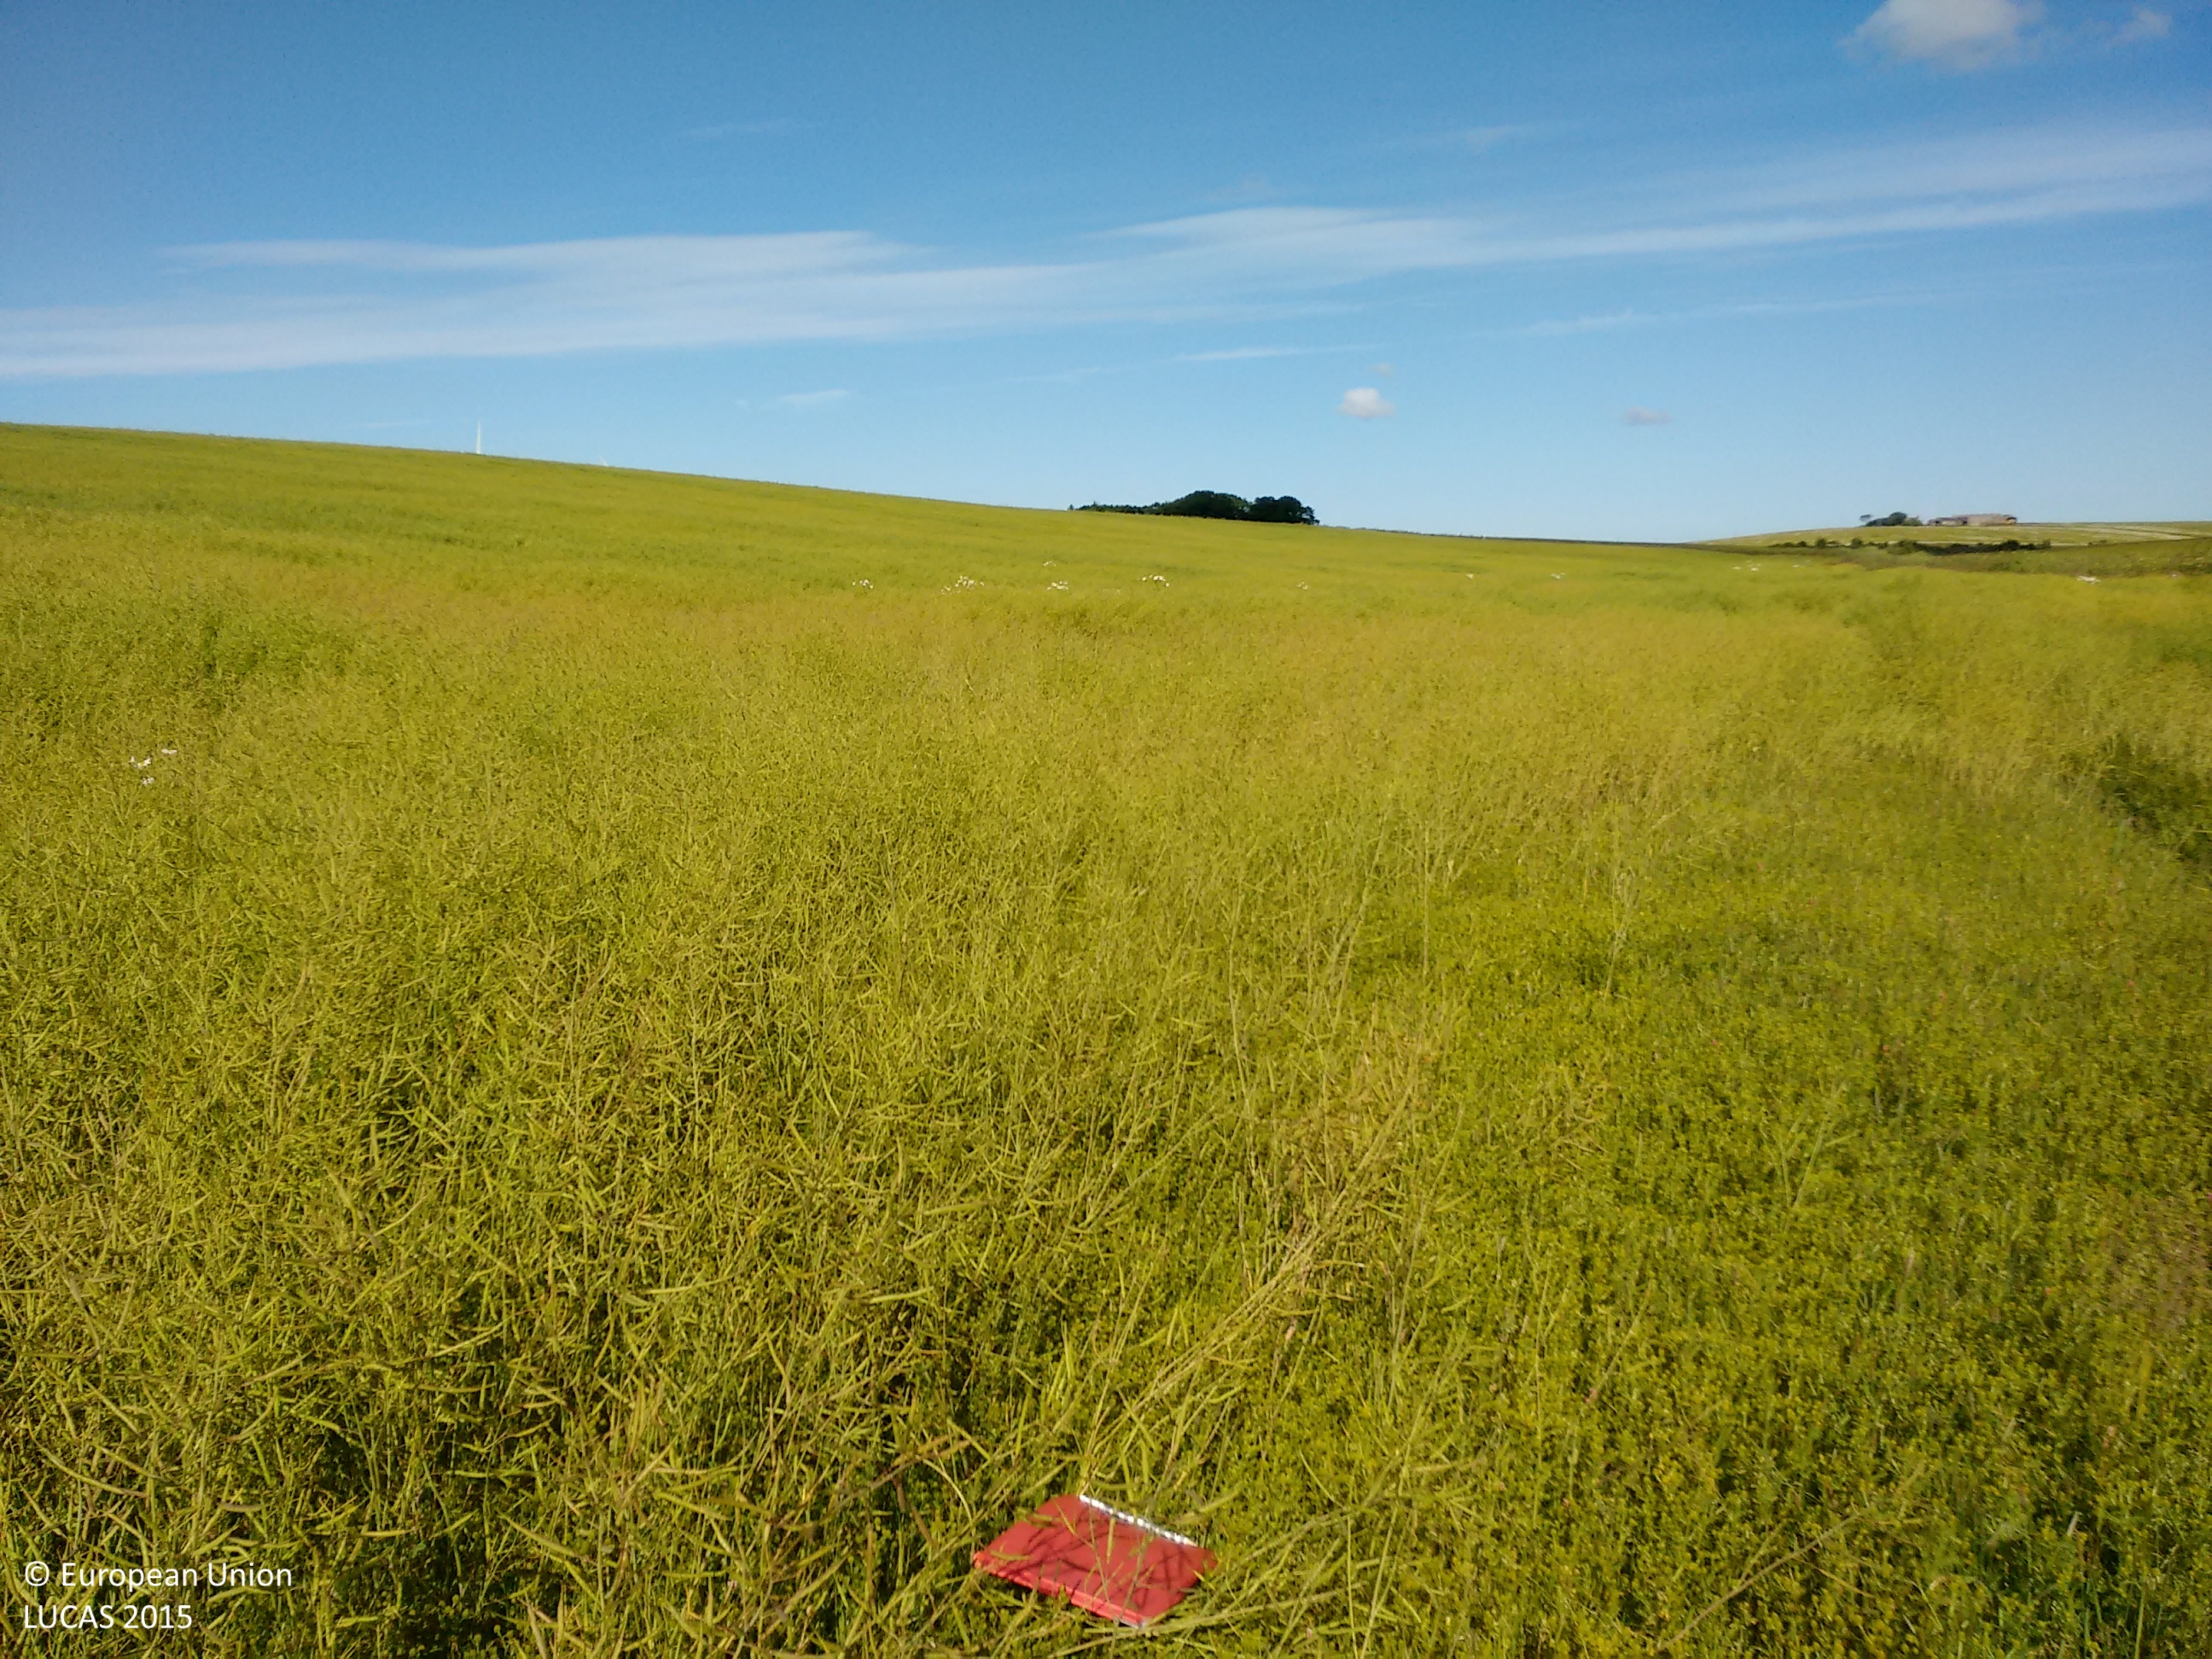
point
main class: Cropland
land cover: Dry pulses
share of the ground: > 75 %
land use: Agriculture (excluding fallow land and kitchen gardens)
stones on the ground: < 10 %
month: July
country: GB
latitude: 57.5823
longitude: -1.8672
